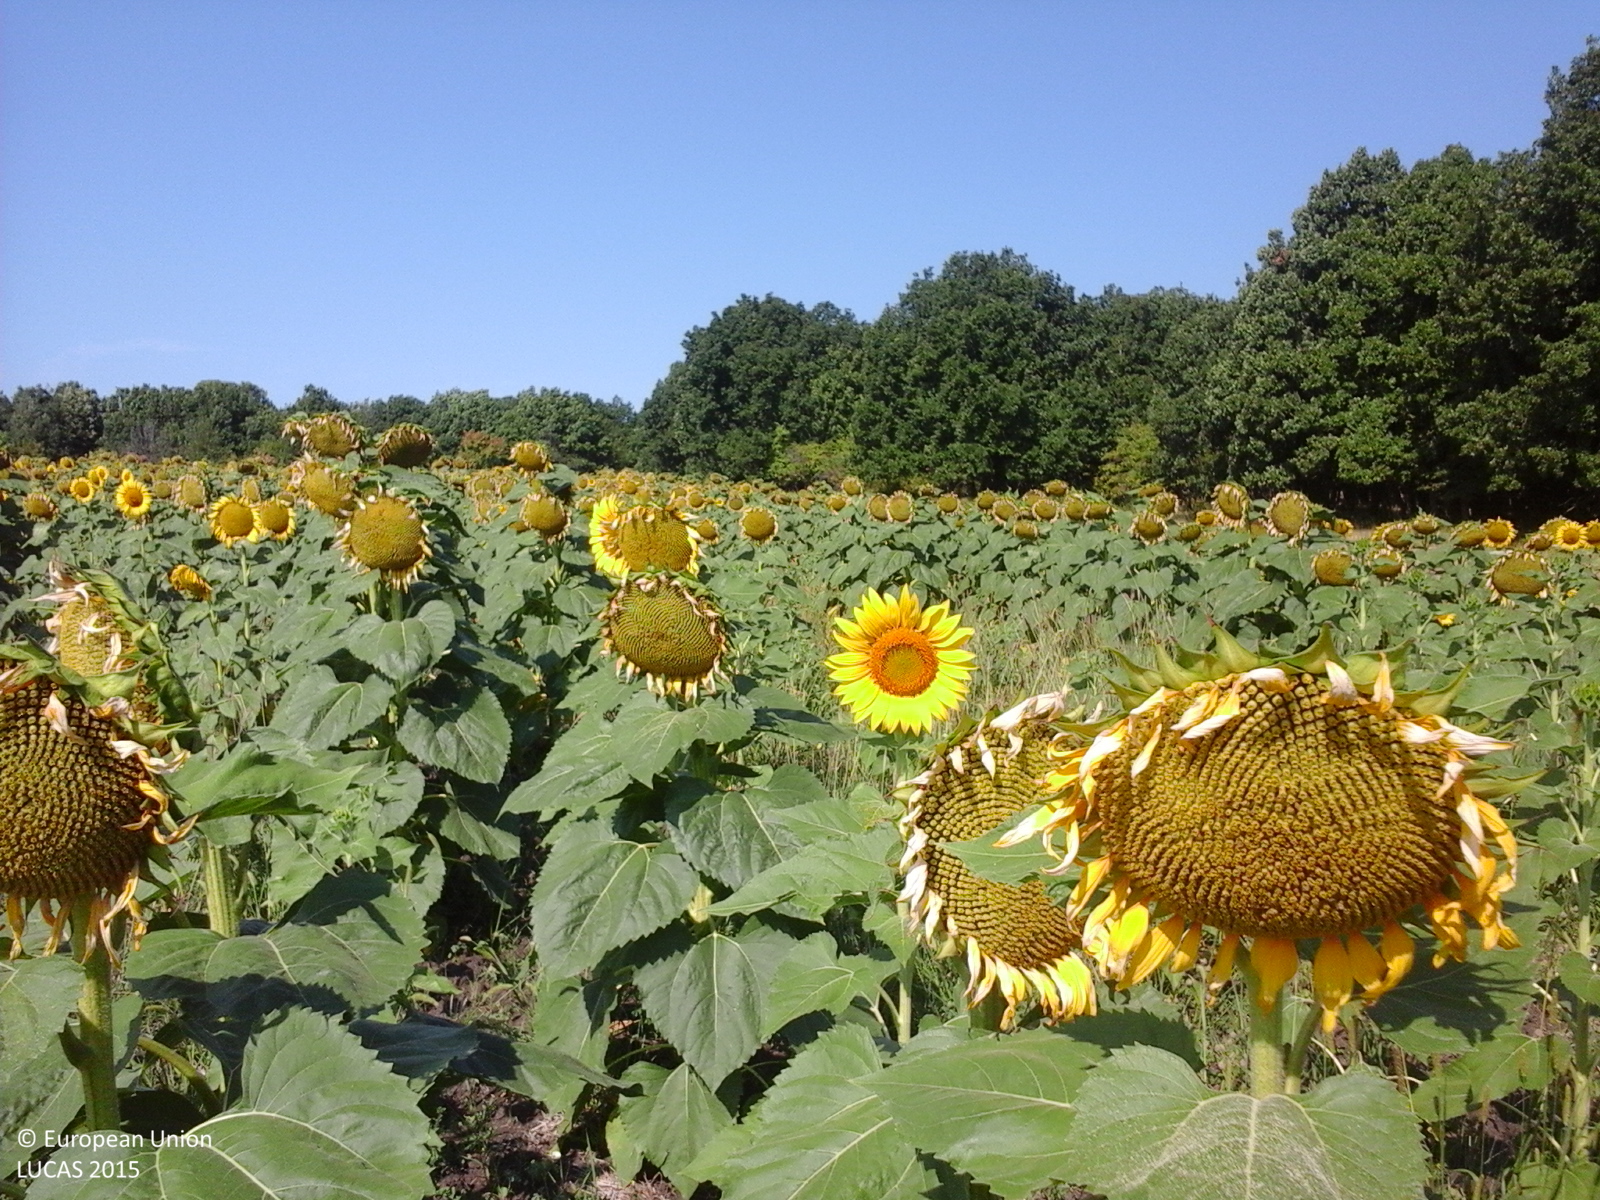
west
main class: Cropland
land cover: Sunflower
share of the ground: > 75 %
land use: Agriculture (excluding fallow land and kitchen gardens)
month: July
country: RO
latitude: 46.0393
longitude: 27.8060
